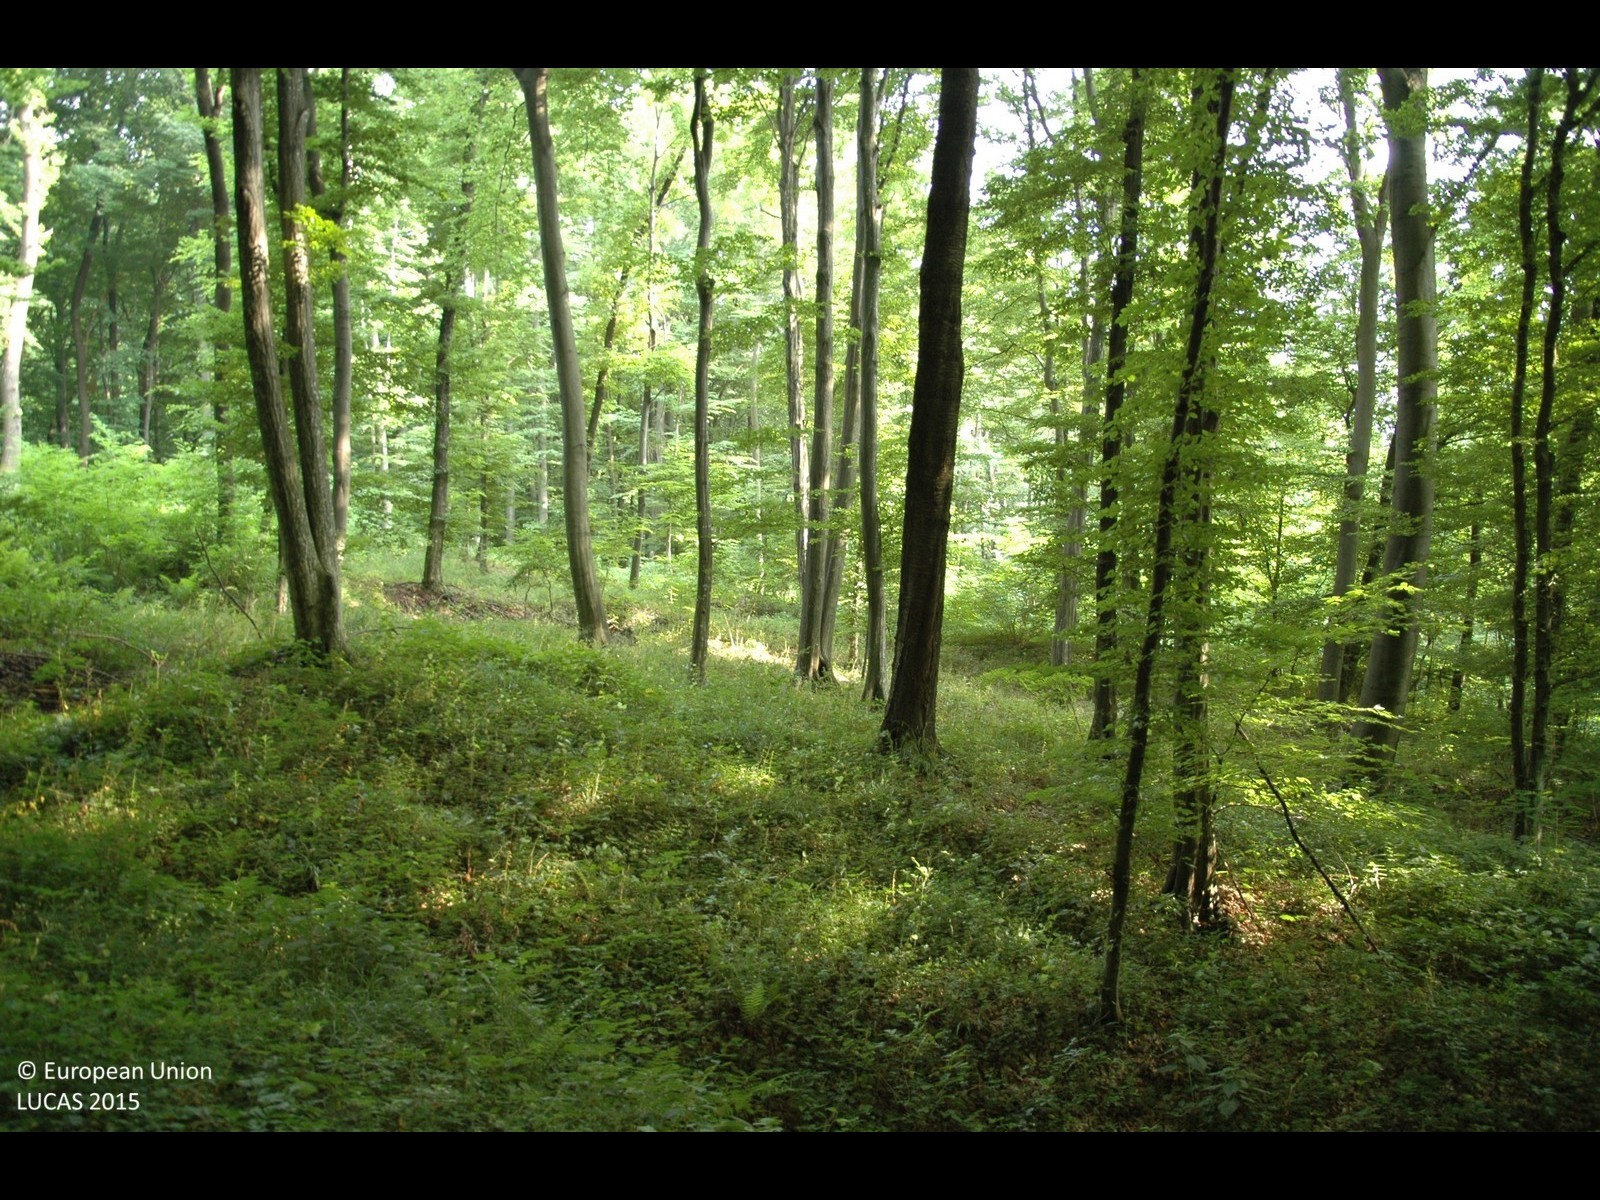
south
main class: Woodland
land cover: Broadleaved woodland
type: beech forest
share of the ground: > 75 %
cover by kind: broadleaved forest trees 100 %
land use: Forestry
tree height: > 5 m
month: June
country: HR
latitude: 46.4879
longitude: 16.3450
